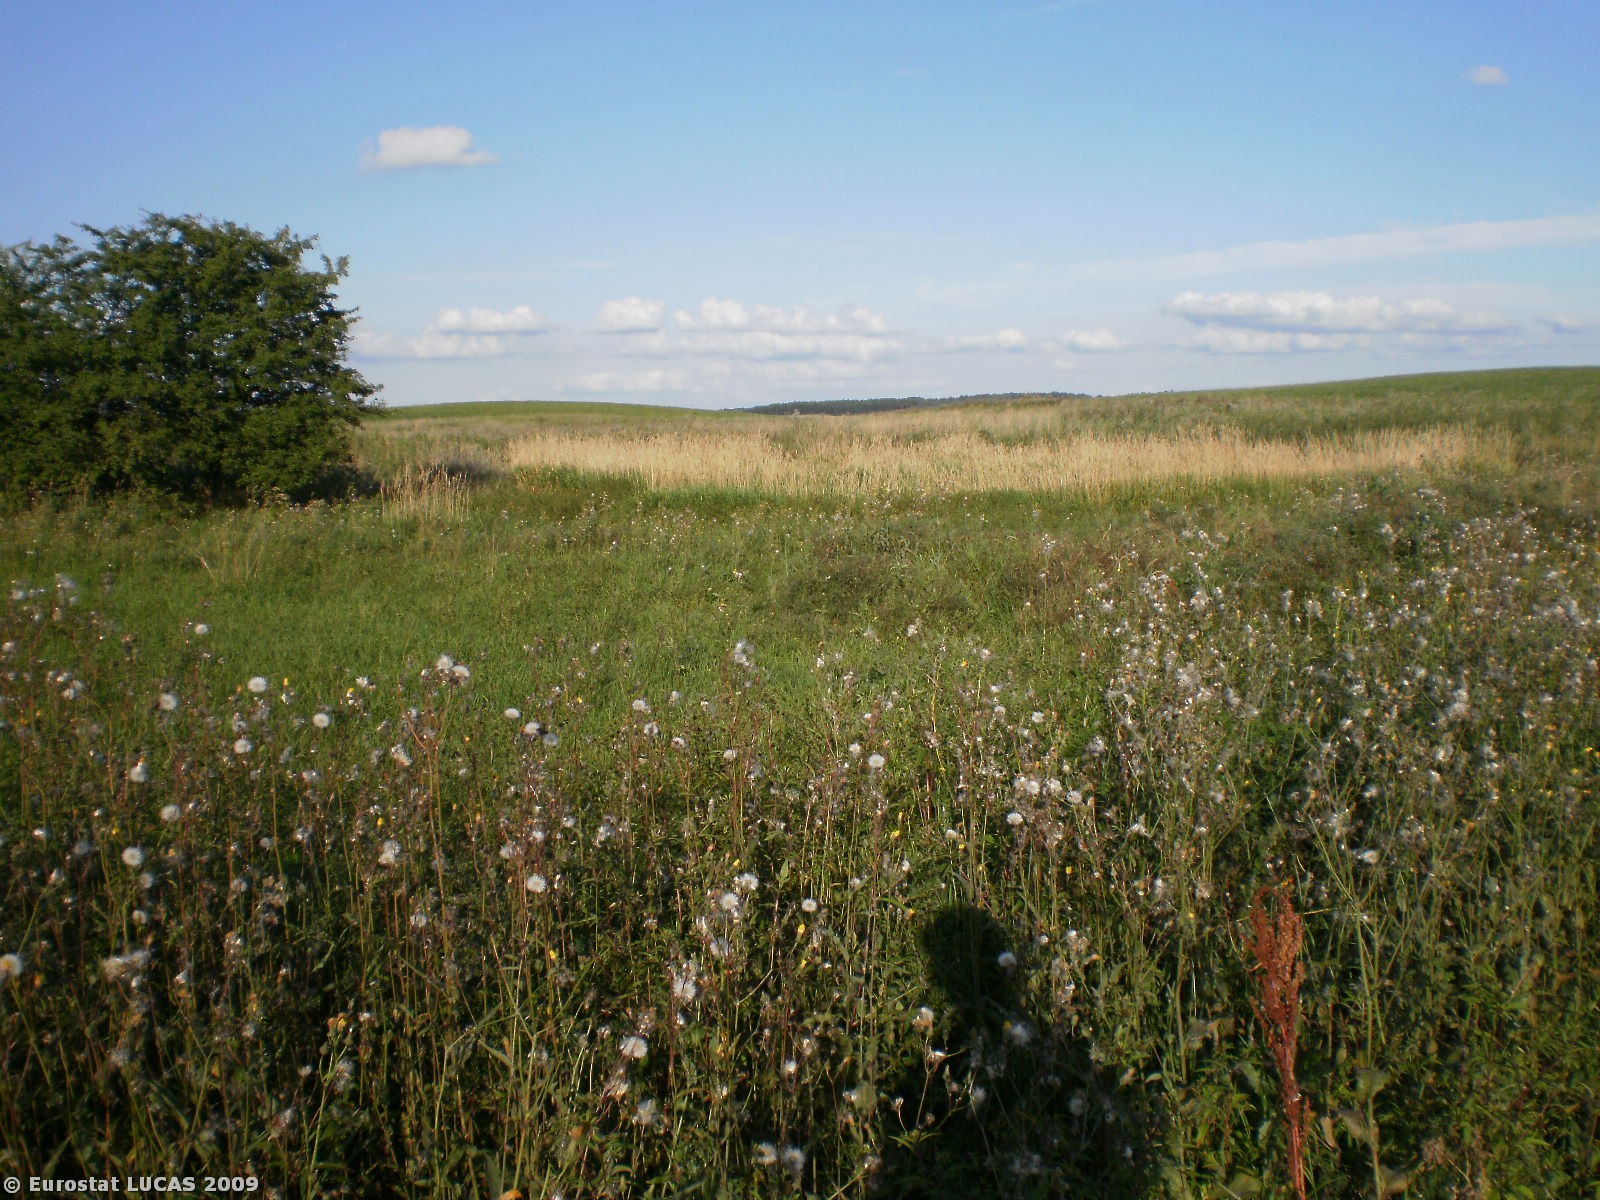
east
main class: Grassland
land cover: Grassland without tree/shrub cover
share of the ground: > 75 %
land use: Unused
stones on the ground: < 10 %
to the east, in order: Grassland without tree/shrub cover; Spontaneously vegetated surfaces; Clovers
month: August
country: PL
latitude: 53.8492
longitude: 21.7116
